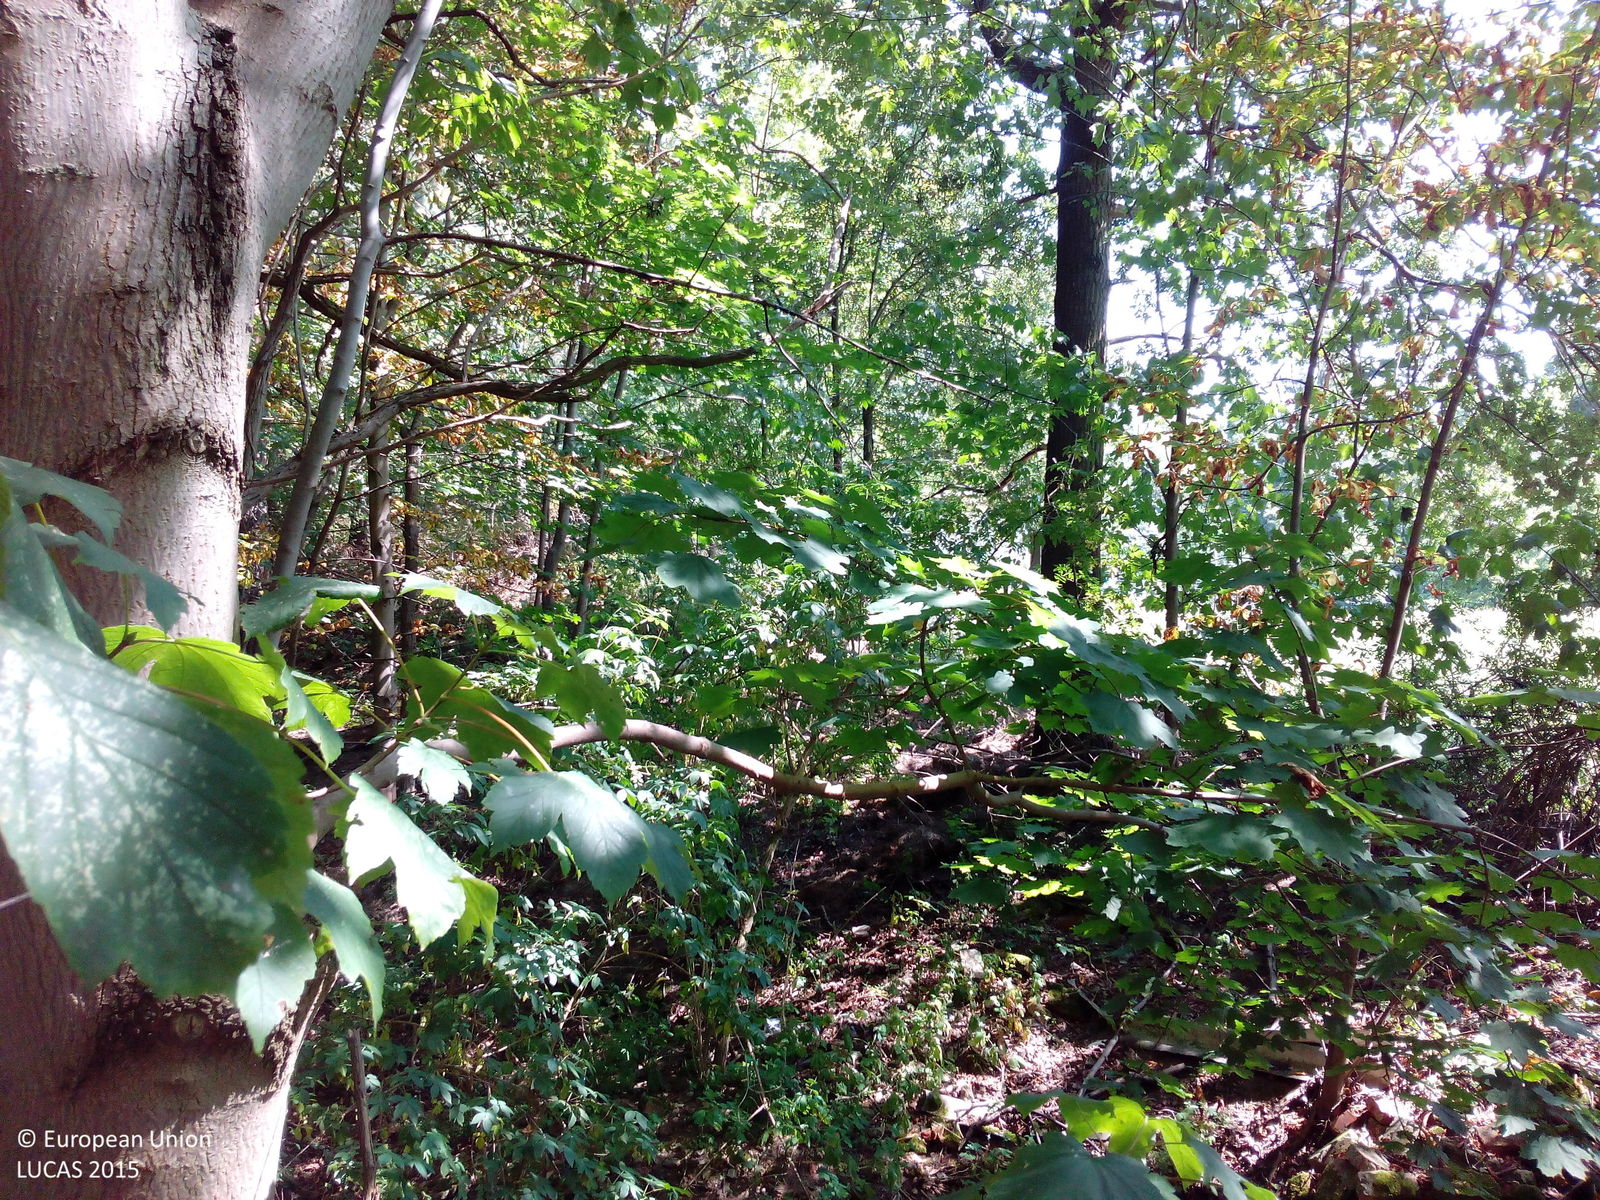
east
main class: Woodland
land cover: Broadleaved woodland
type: mesophytic deciduous forest
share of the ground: > 75 %
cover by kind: broadleaved forest trees 95 %, unconsolidated bare surface 5 %
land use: Forestry
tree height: > 5 m
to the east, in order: Broadleaved woodland; Fences; Tracks; Fences; Broadleaved woodland; Pine dominated coniferous woodland
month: August
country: DE
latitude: 51.8697
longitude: 11.0309
